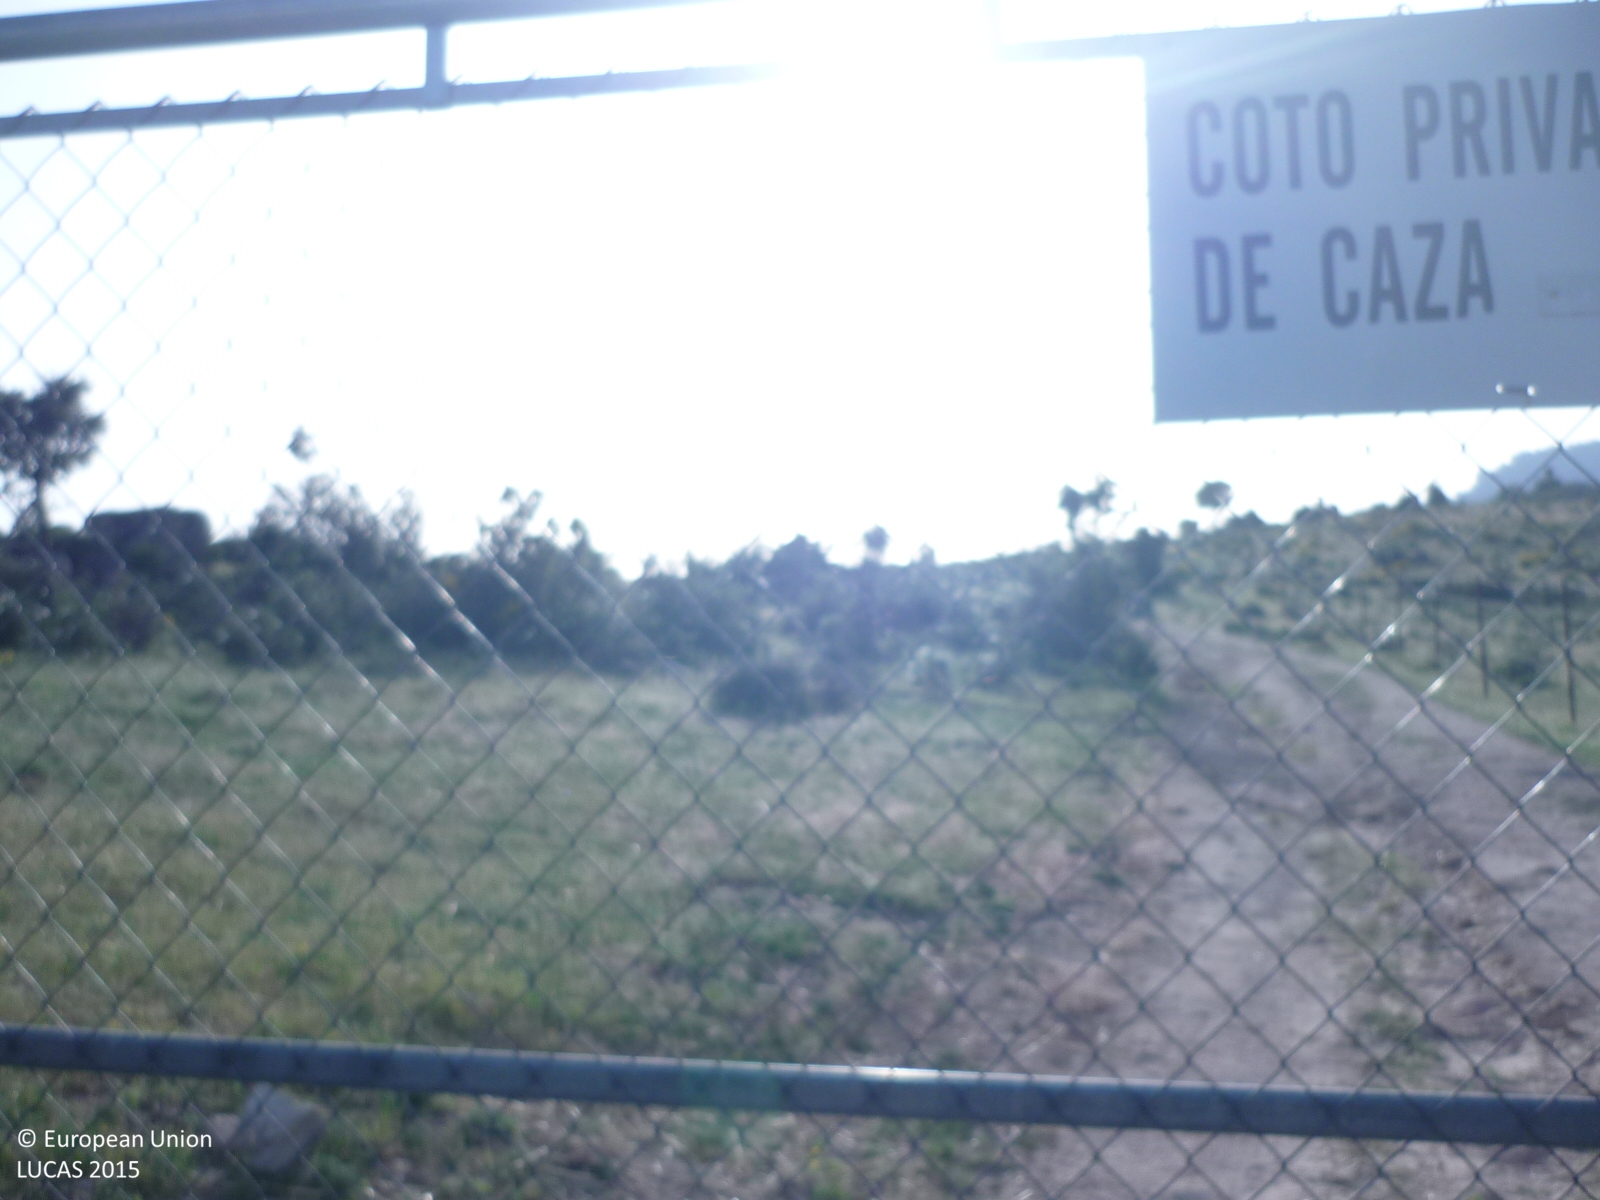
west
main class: Grassland
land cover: Grassland with sparse tree/shrub cover
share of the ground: > 75 %
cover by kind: herbaceous plants 85 %, shrubs 10 %, broadleaved forest trees 5 %
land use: Agriculture (excluding fallow land and kitchen gardens)
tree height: < 5 m
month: May
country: ES
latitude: 40.7224
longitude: -3.8837
